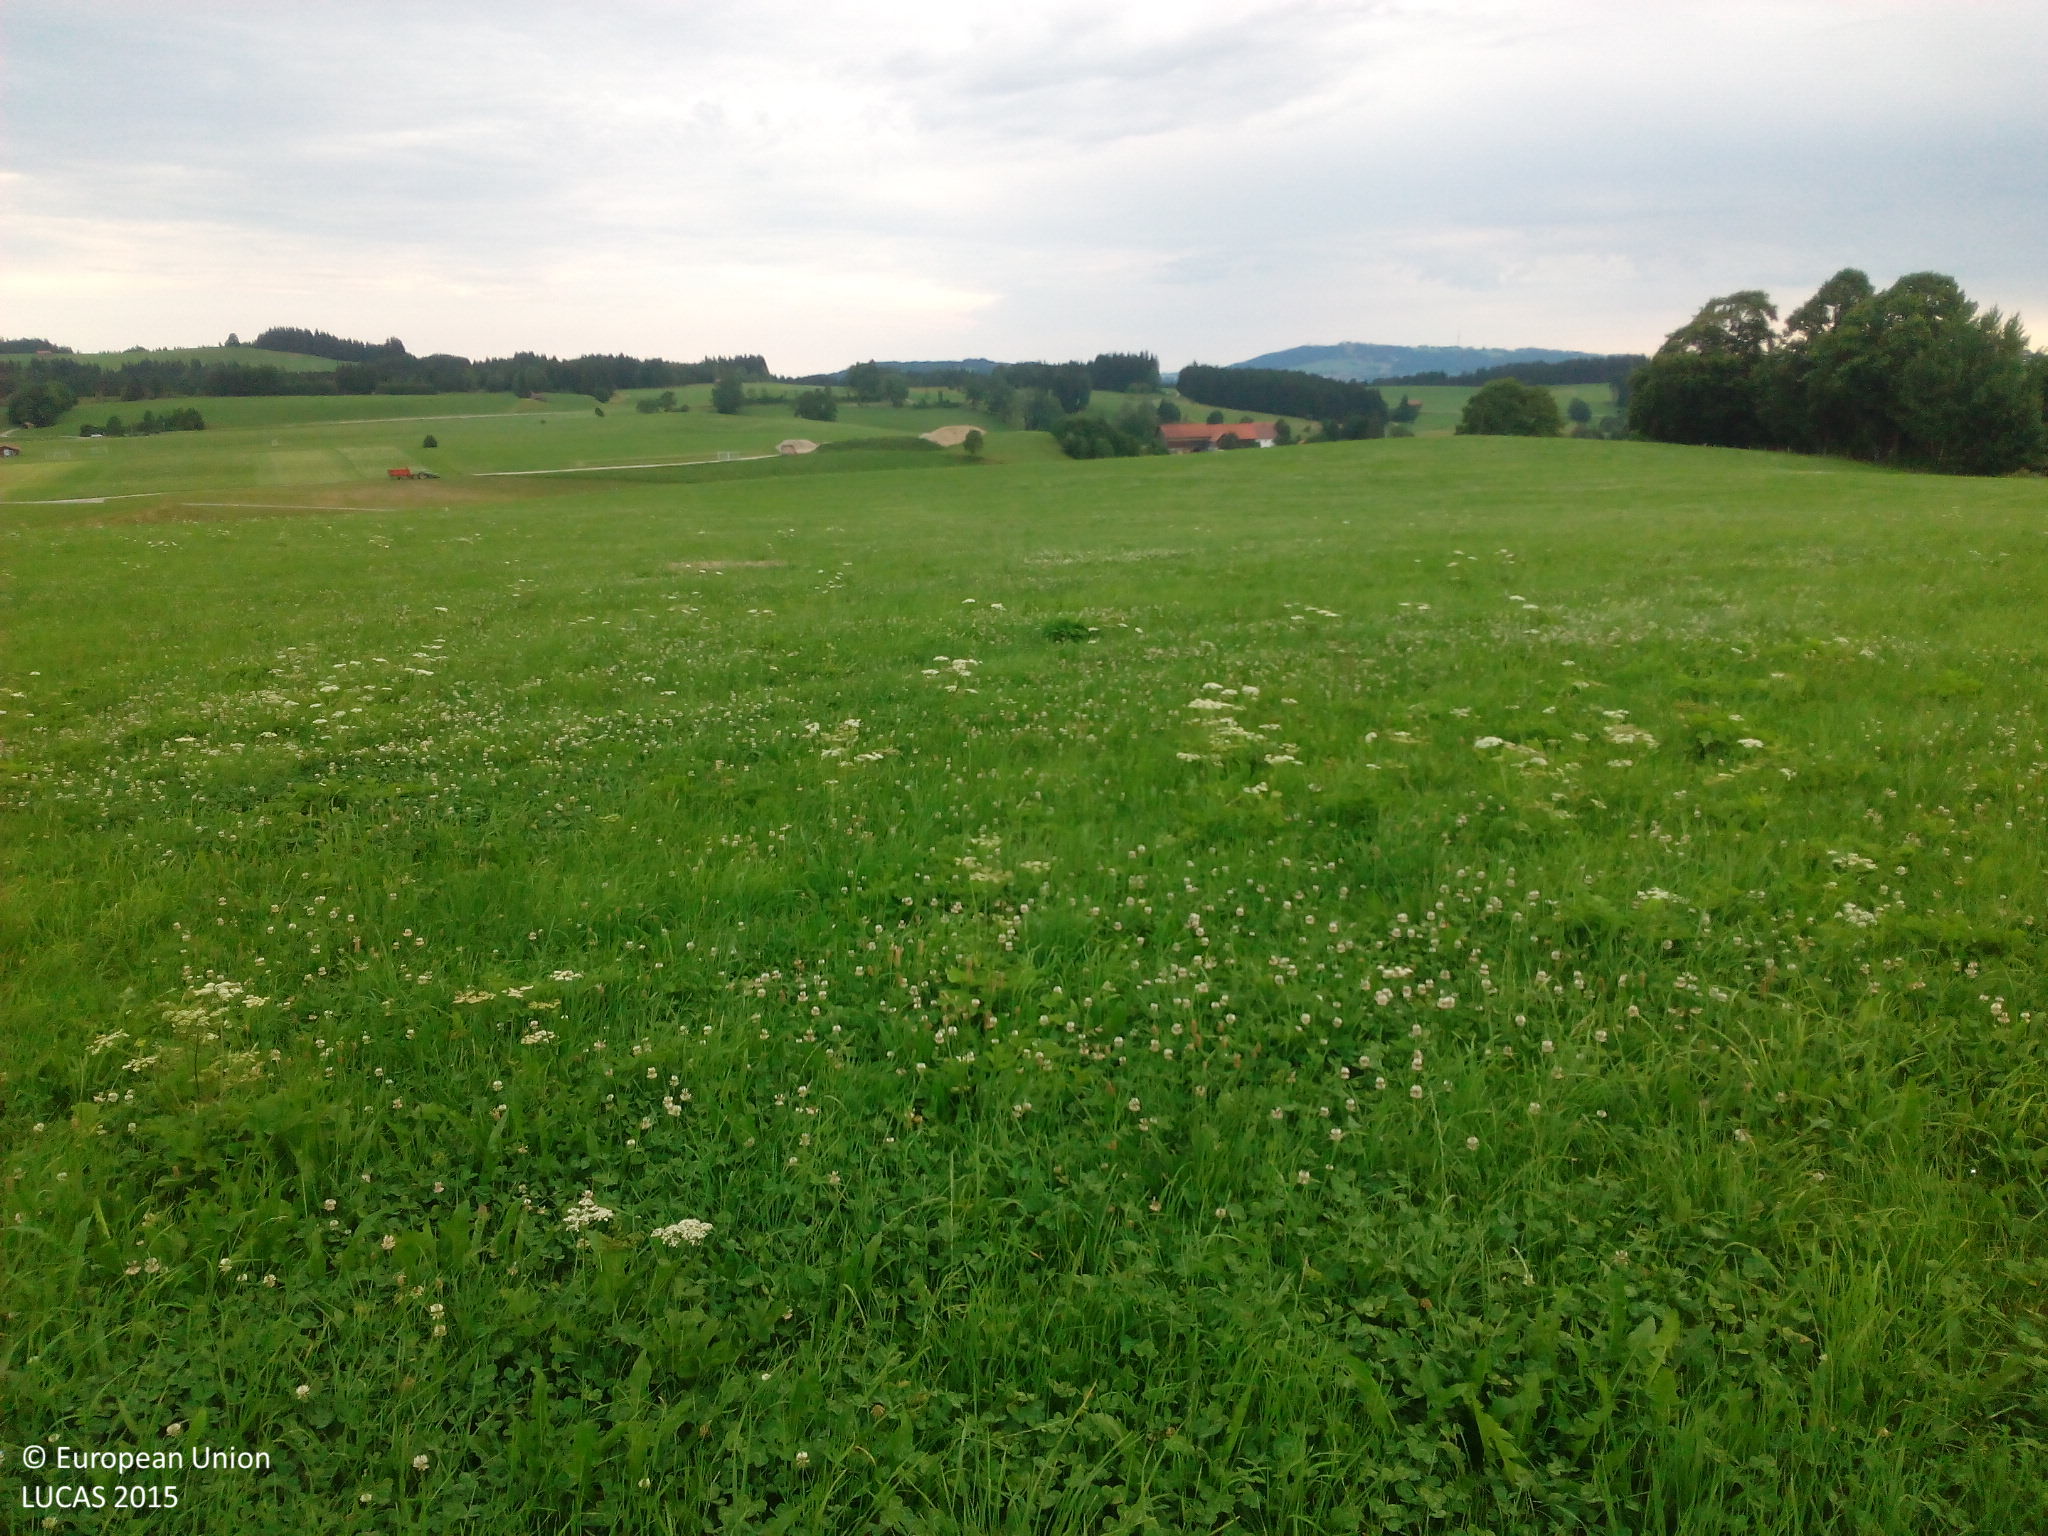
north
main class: Grassland
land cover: Grassland without tree/shrub cover
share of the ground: > 75 %
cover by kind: herbaceous plants 100 %
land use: Agriculture (excluding fallow land and kitchen gardens)
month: July
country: DE
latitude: 47.6975
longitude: 10.9453
